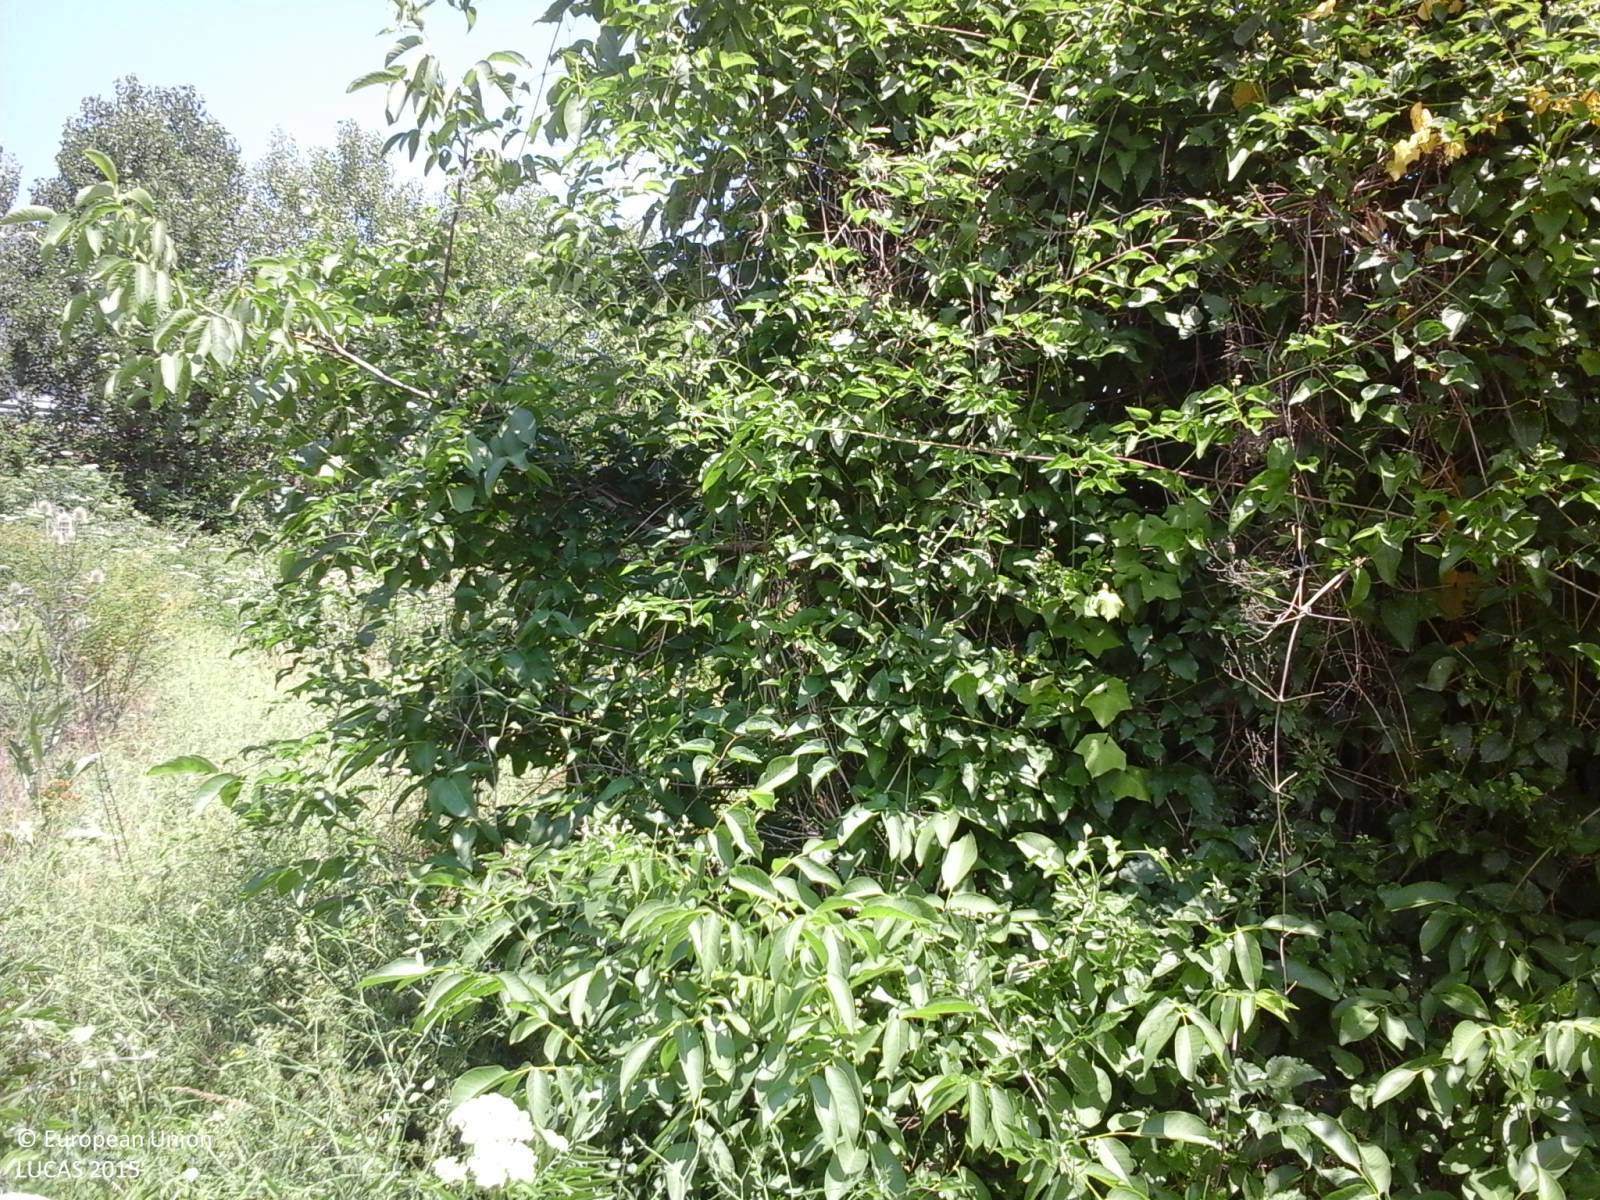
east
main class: Cropland
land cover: Barley
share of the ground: > 75 %
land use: Agriculture (excluding fallow land and kitchen gardens)
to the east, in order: Barley; Fences; Abandoned hedges; Spontaneously vegetated surfaces; Lines of trees; Paved roads, cycling and walking lanes; Lines of trees; Grassland without tree/shrub cover; Paved roads, cycling and walking lanes; Grassland without tree/shrub cover; Paved roads, cycling and walking lanes; Lucerne; Abandoned hedges; Mixed cereals for fodder; Broadleaved woodland; Mixed cereals for fodder
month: July
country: IT
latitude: 42.4381
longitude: 13.2840
